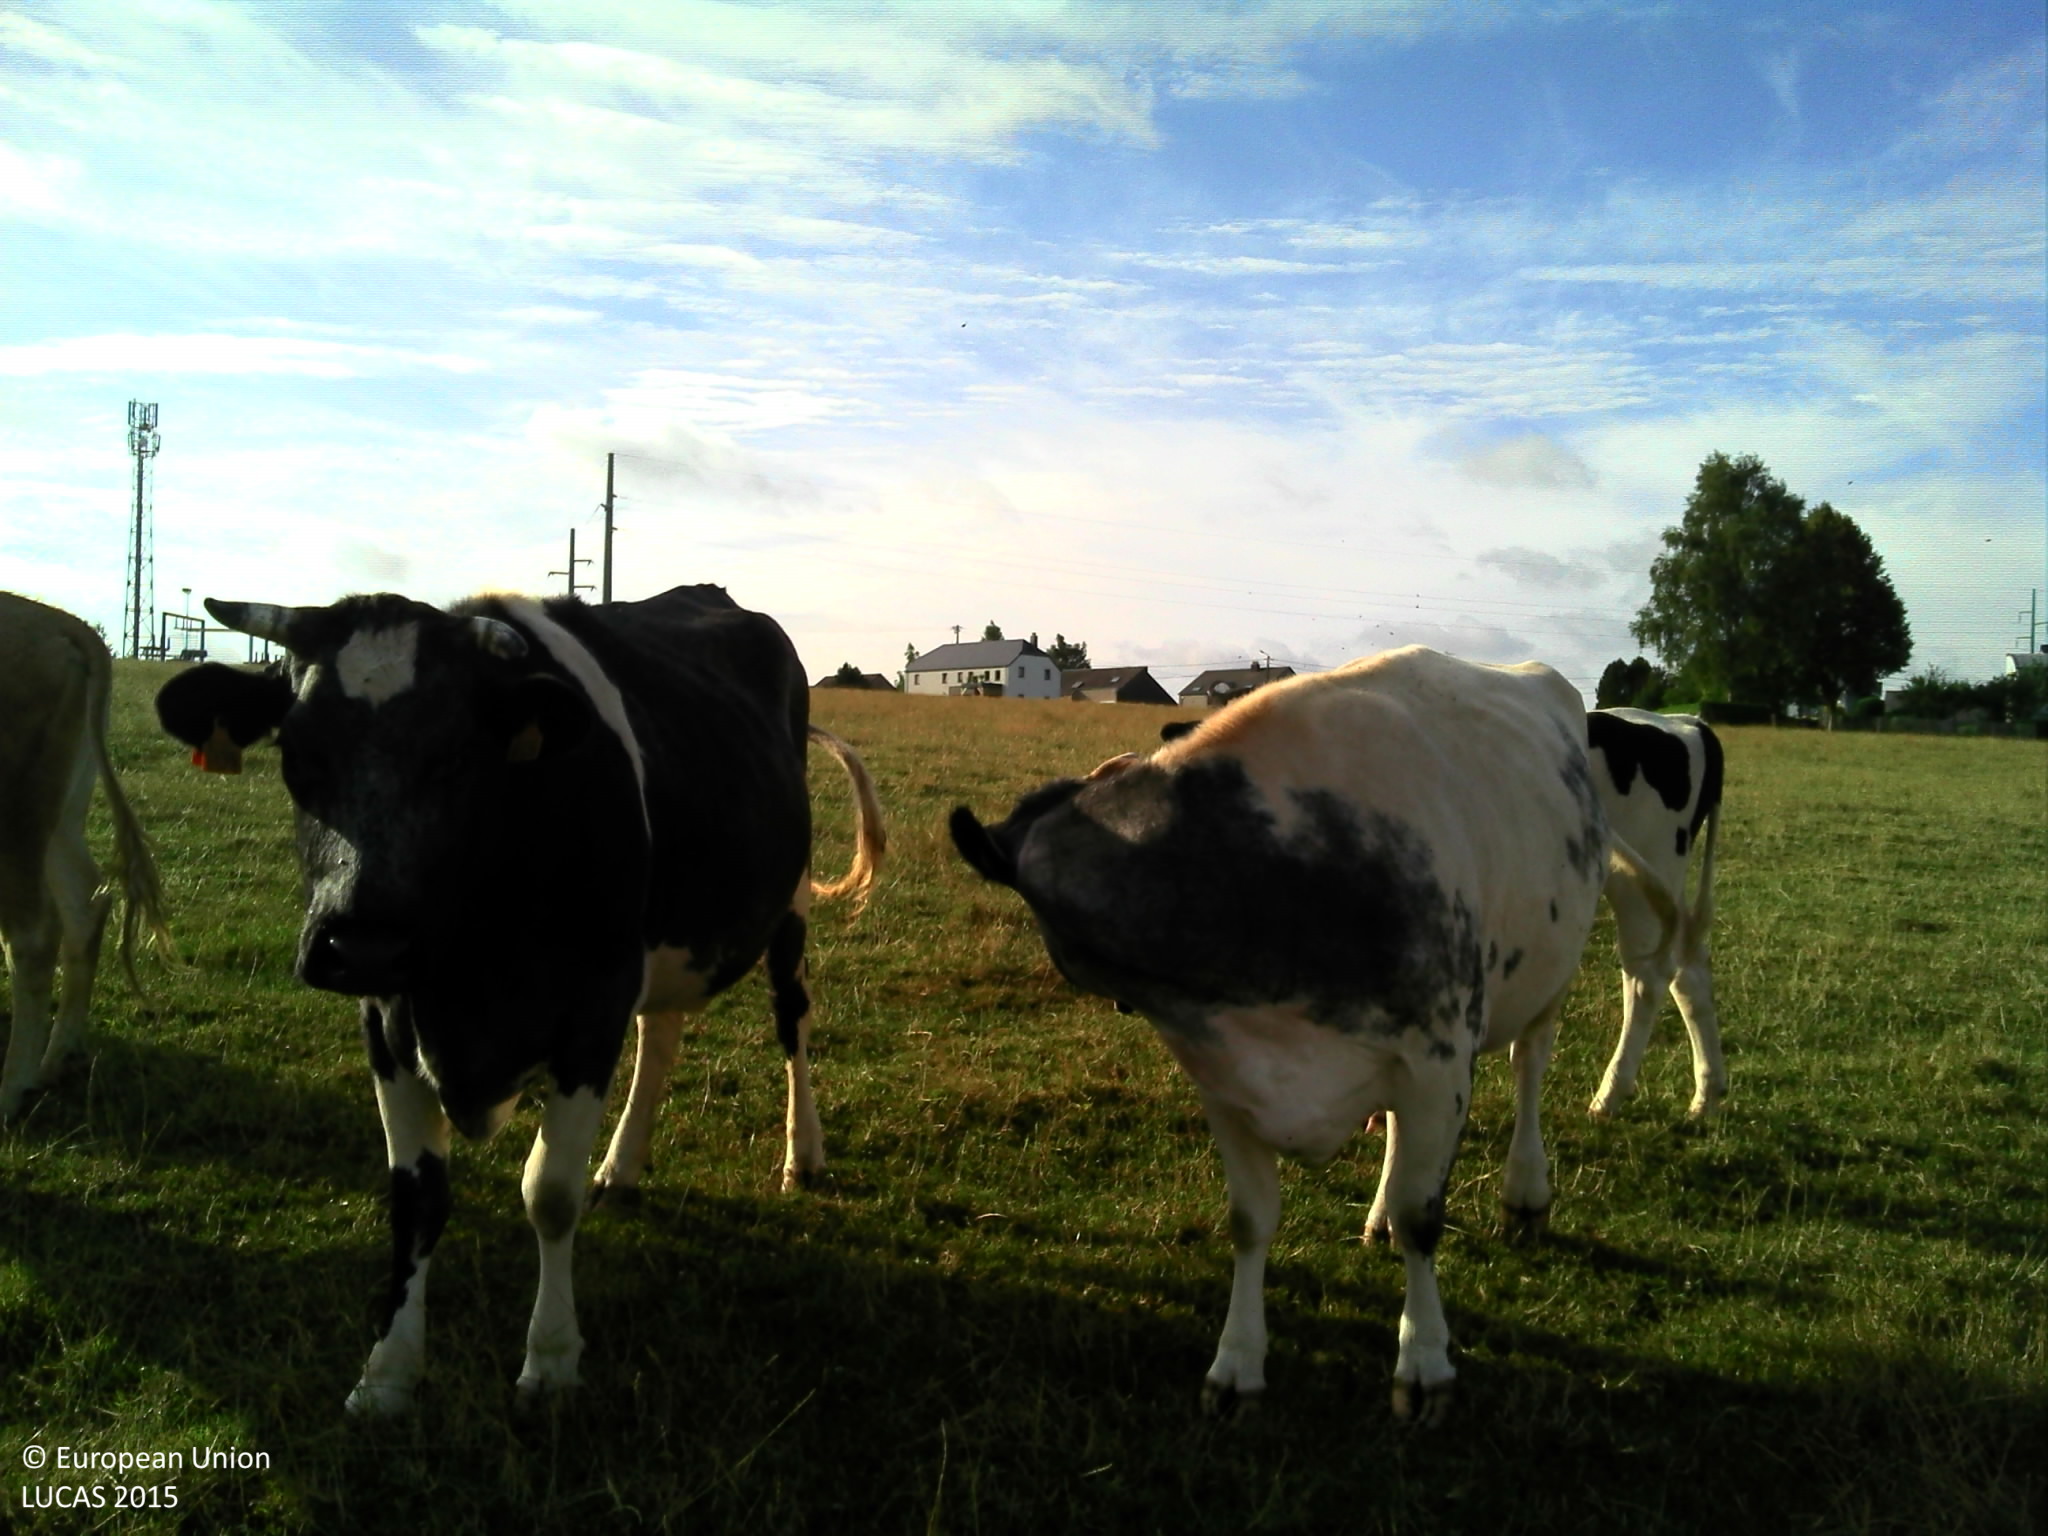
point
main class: Grassland
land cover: Grassland without tree/shrub cover
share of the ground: > 75 %
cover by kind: herbaceous plants 100 %
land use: Agriculture (excluding fallow land and kitchen gardens)
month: July
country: BE
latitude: 49.7117
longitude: 5.8247
